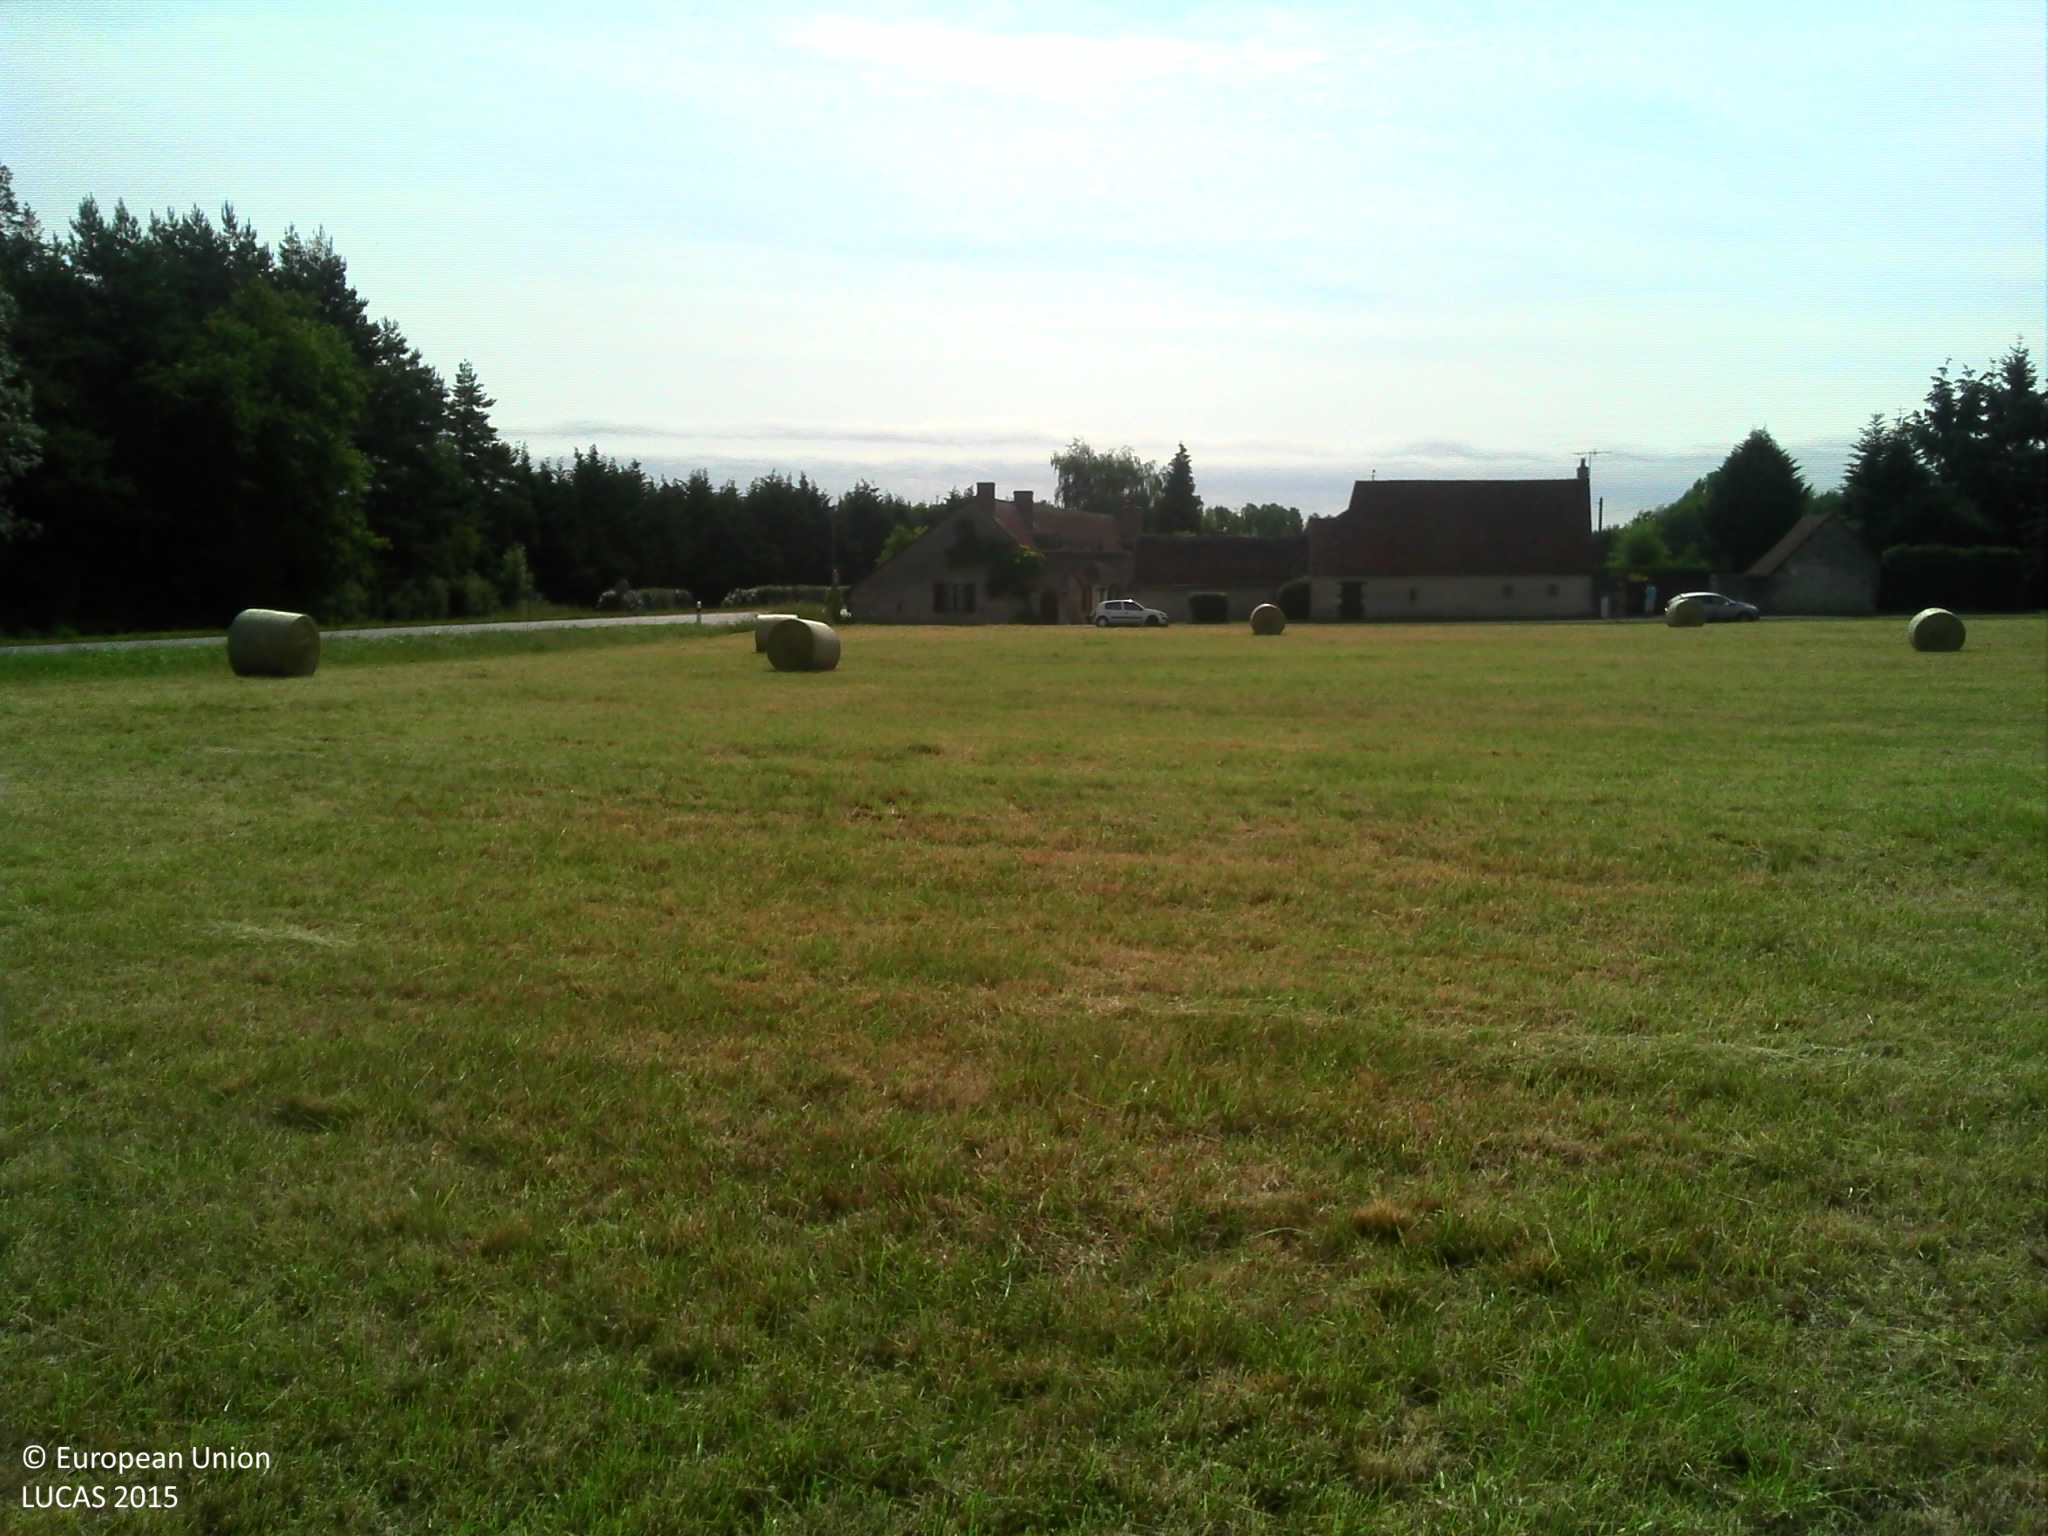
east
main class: Grassland
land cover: Grassland without tree/shrub cover
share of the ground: > 75 %
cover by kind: herbaceous plants 100 %
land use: Agriculture (excluding fallow land and kitchen gardens)
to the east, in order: Grassland without tree/shrub cover; Ditches and canals; Grass margins; Paved roads, cycling and walking lanes; Grassland without tree/shrub cover; Conifer hedges; Grassland with sparse tree/shrub cover; Spruce dominated coniferous woodland
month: June
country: FR
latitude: 47.4950
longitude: 1.4774
